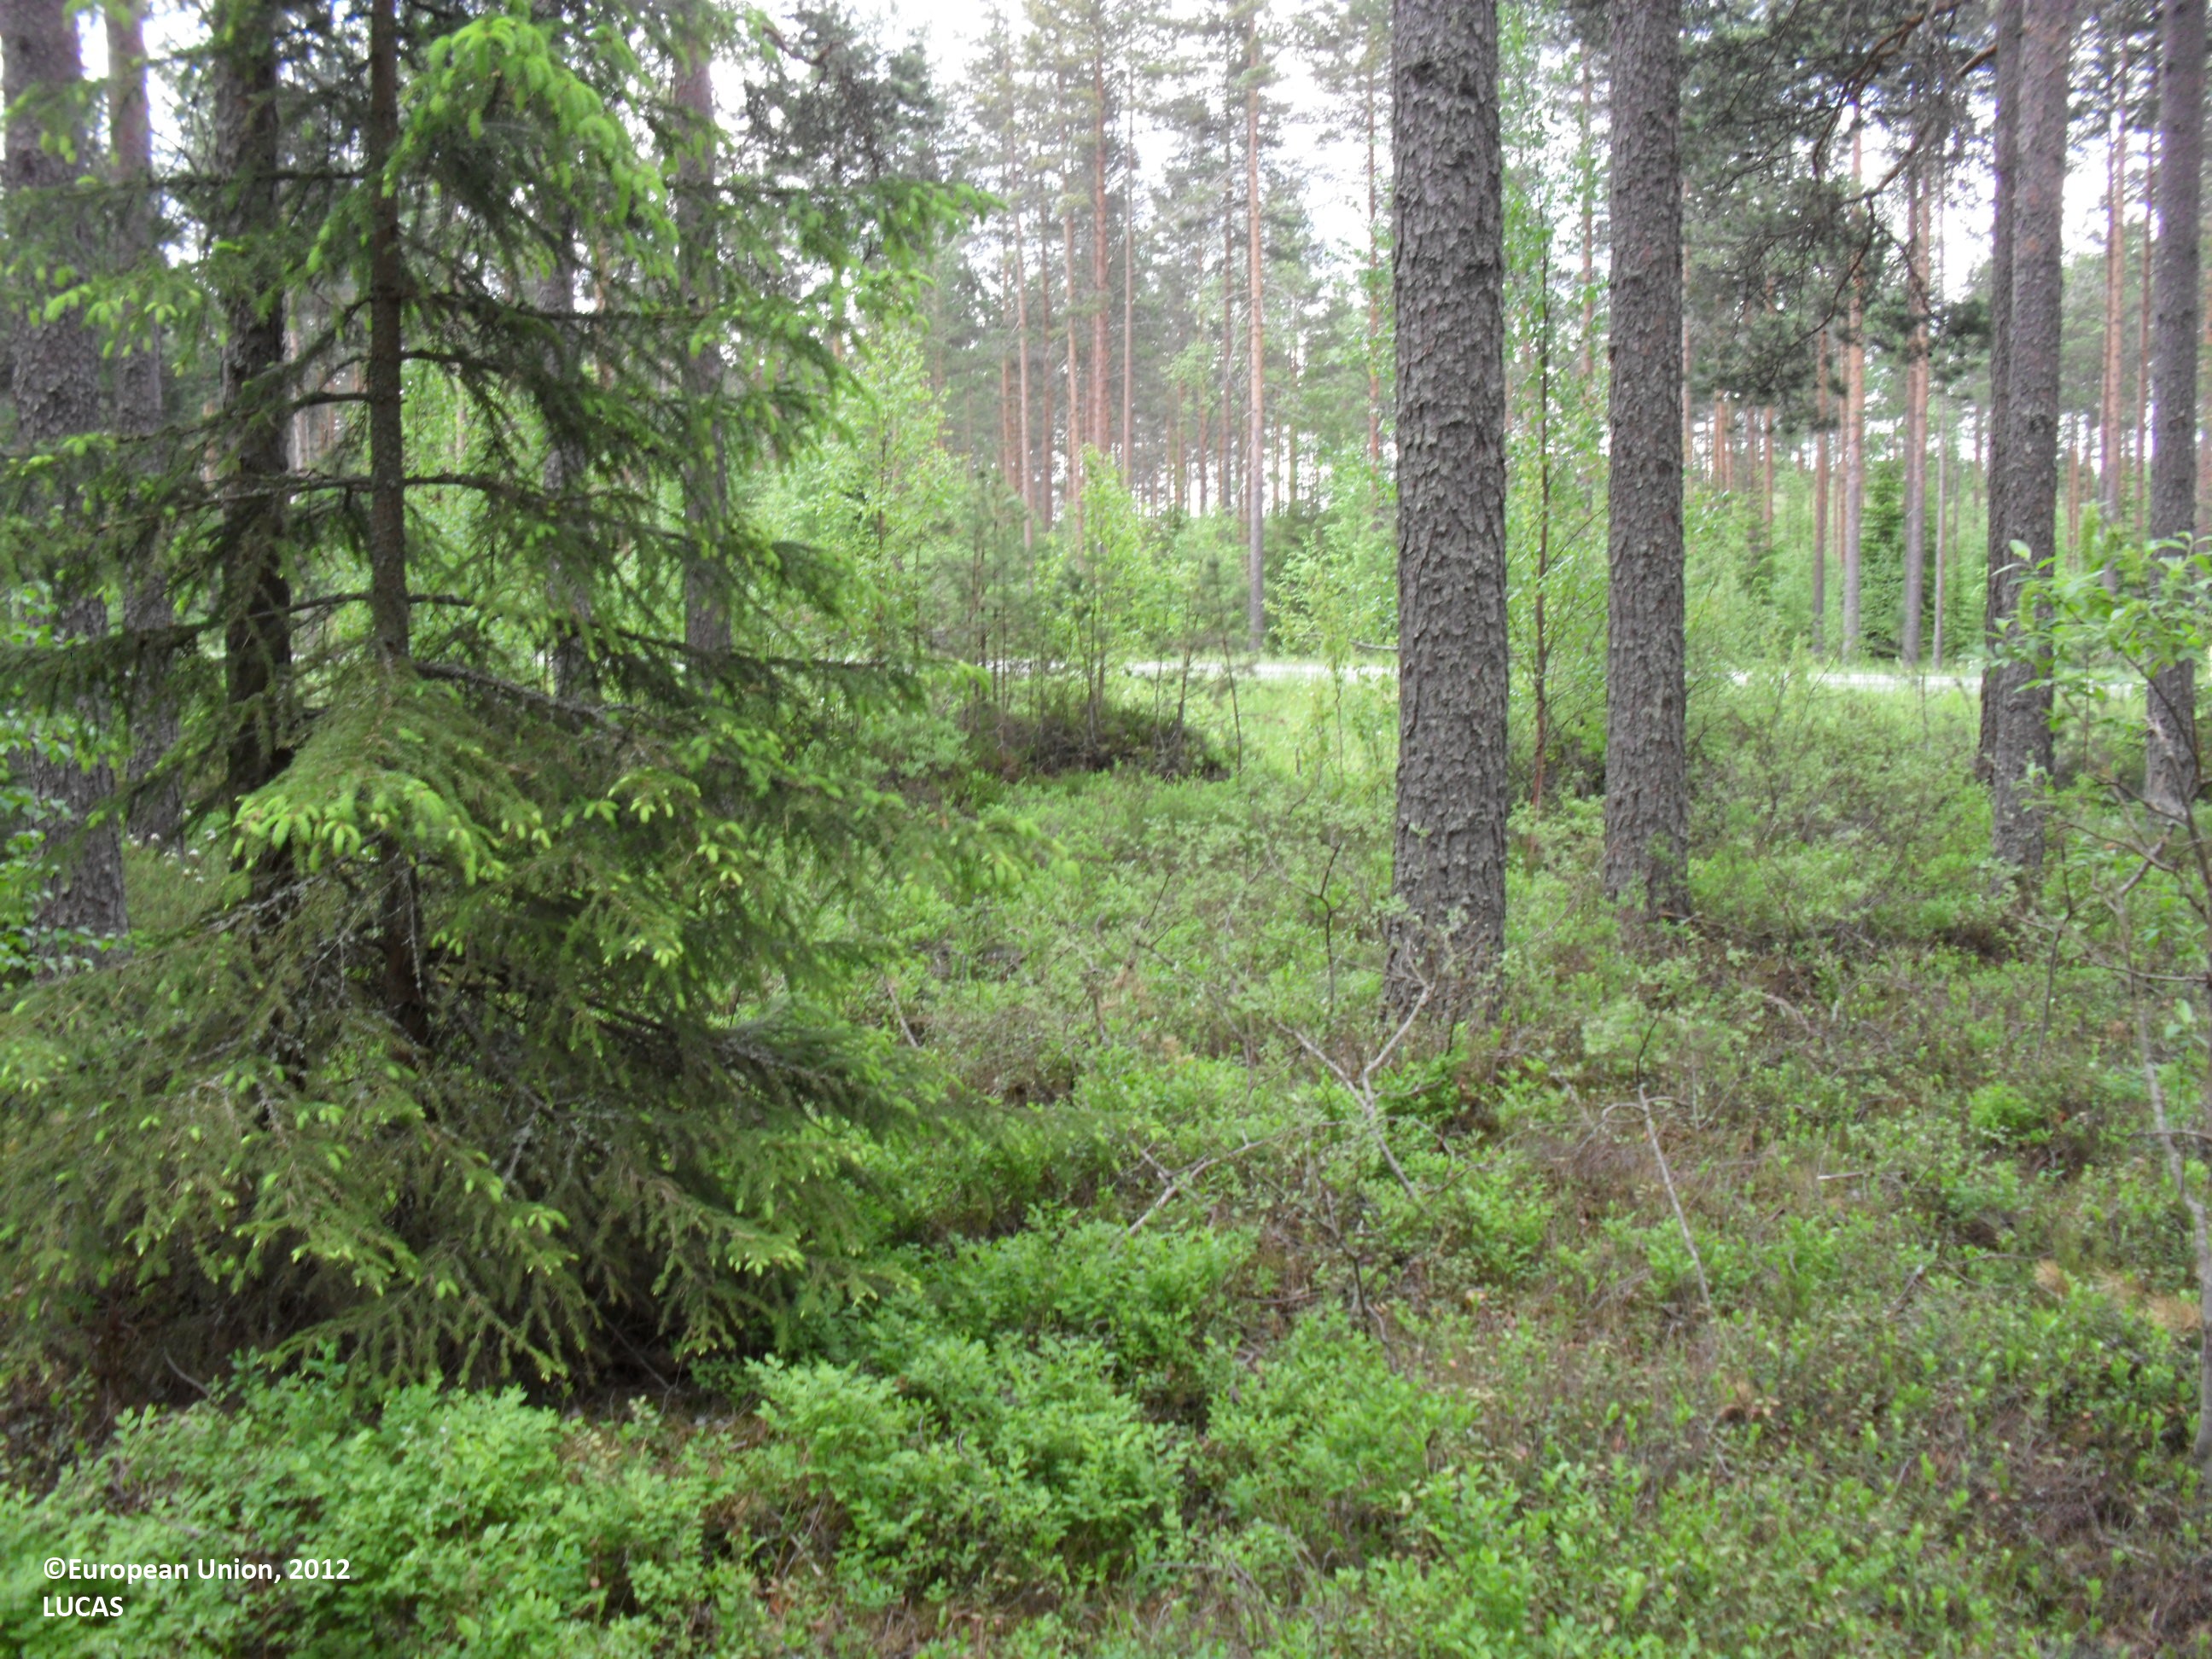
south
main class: Woodland
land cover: Pine dominated coniferous woodland
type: boreal forest
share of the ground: 50 - 75 %
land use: Forestry
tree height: > 5 m
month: June
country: FI
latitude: 62.7650
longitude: 23.3657
